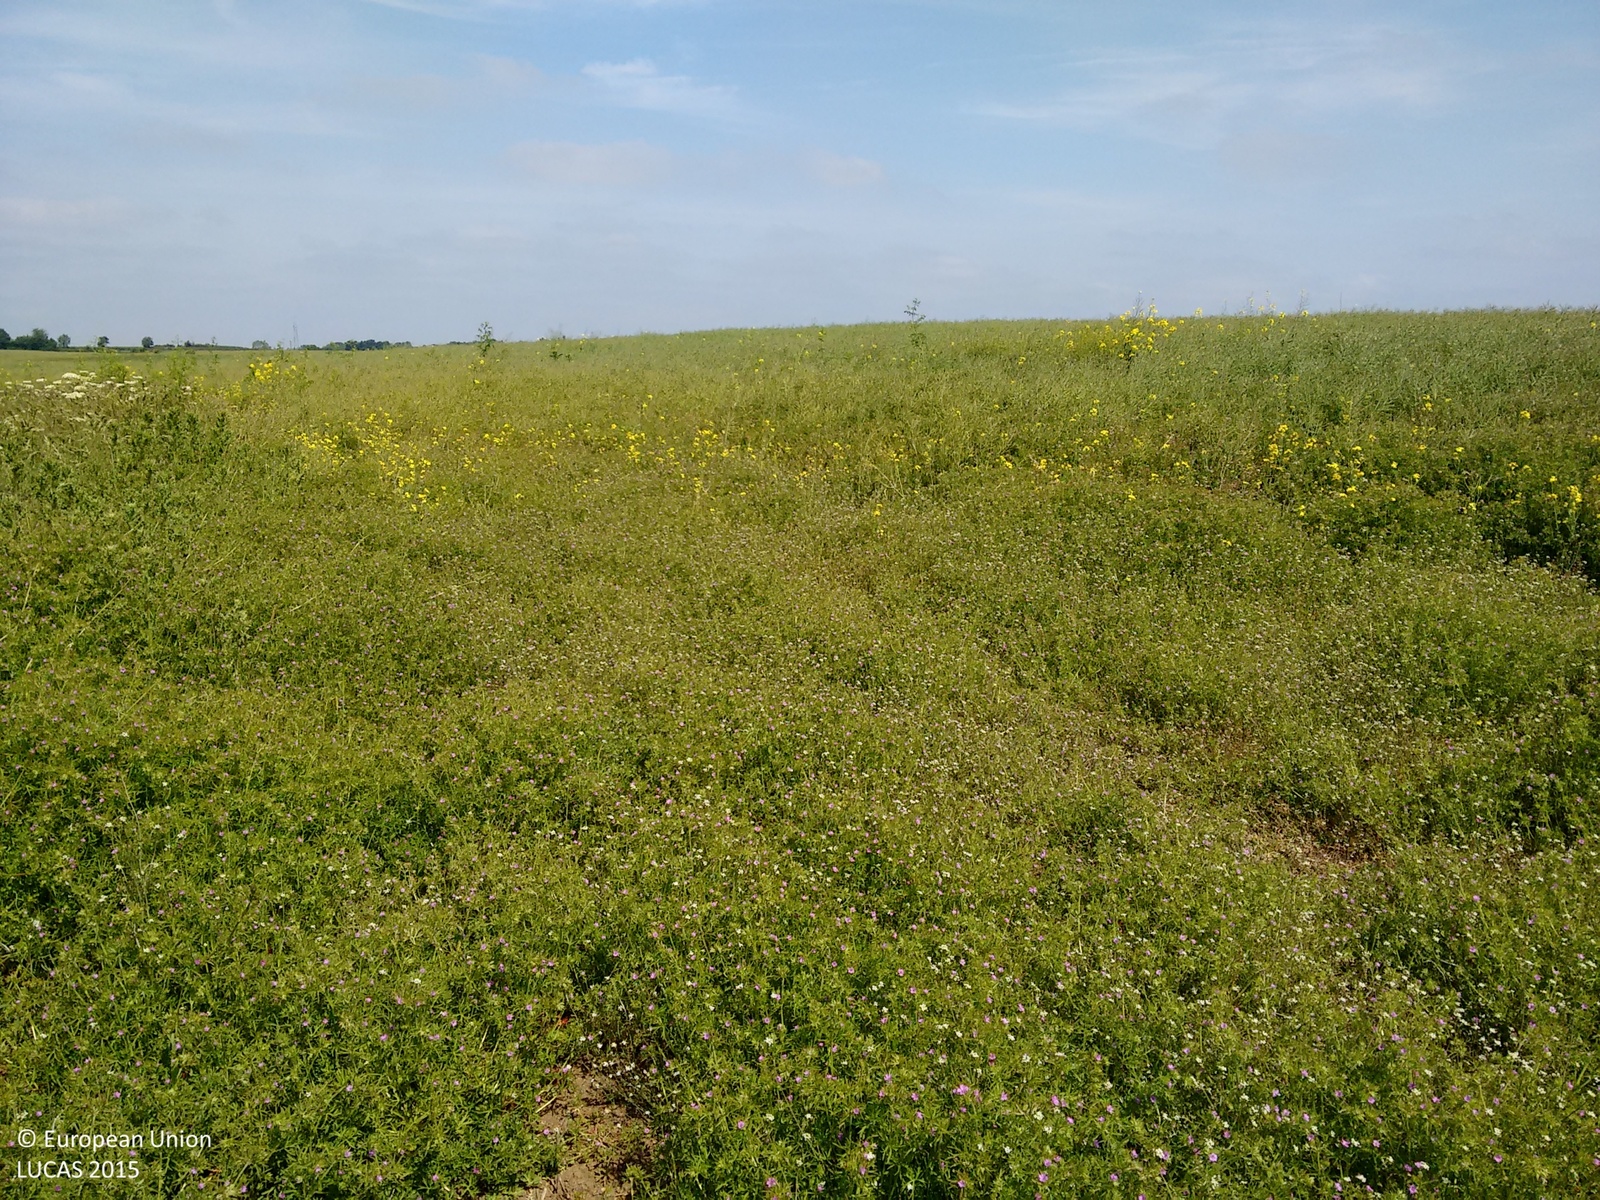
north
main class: Grassland
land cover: Spontaneously vegetated surfaces
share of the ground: > 75 %
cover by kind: herbaceous plants 100 %
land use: Agriculture (excluding fallow land and kitchen gardens)
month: June
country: GB
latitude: 52.9614
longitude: -0.7145
